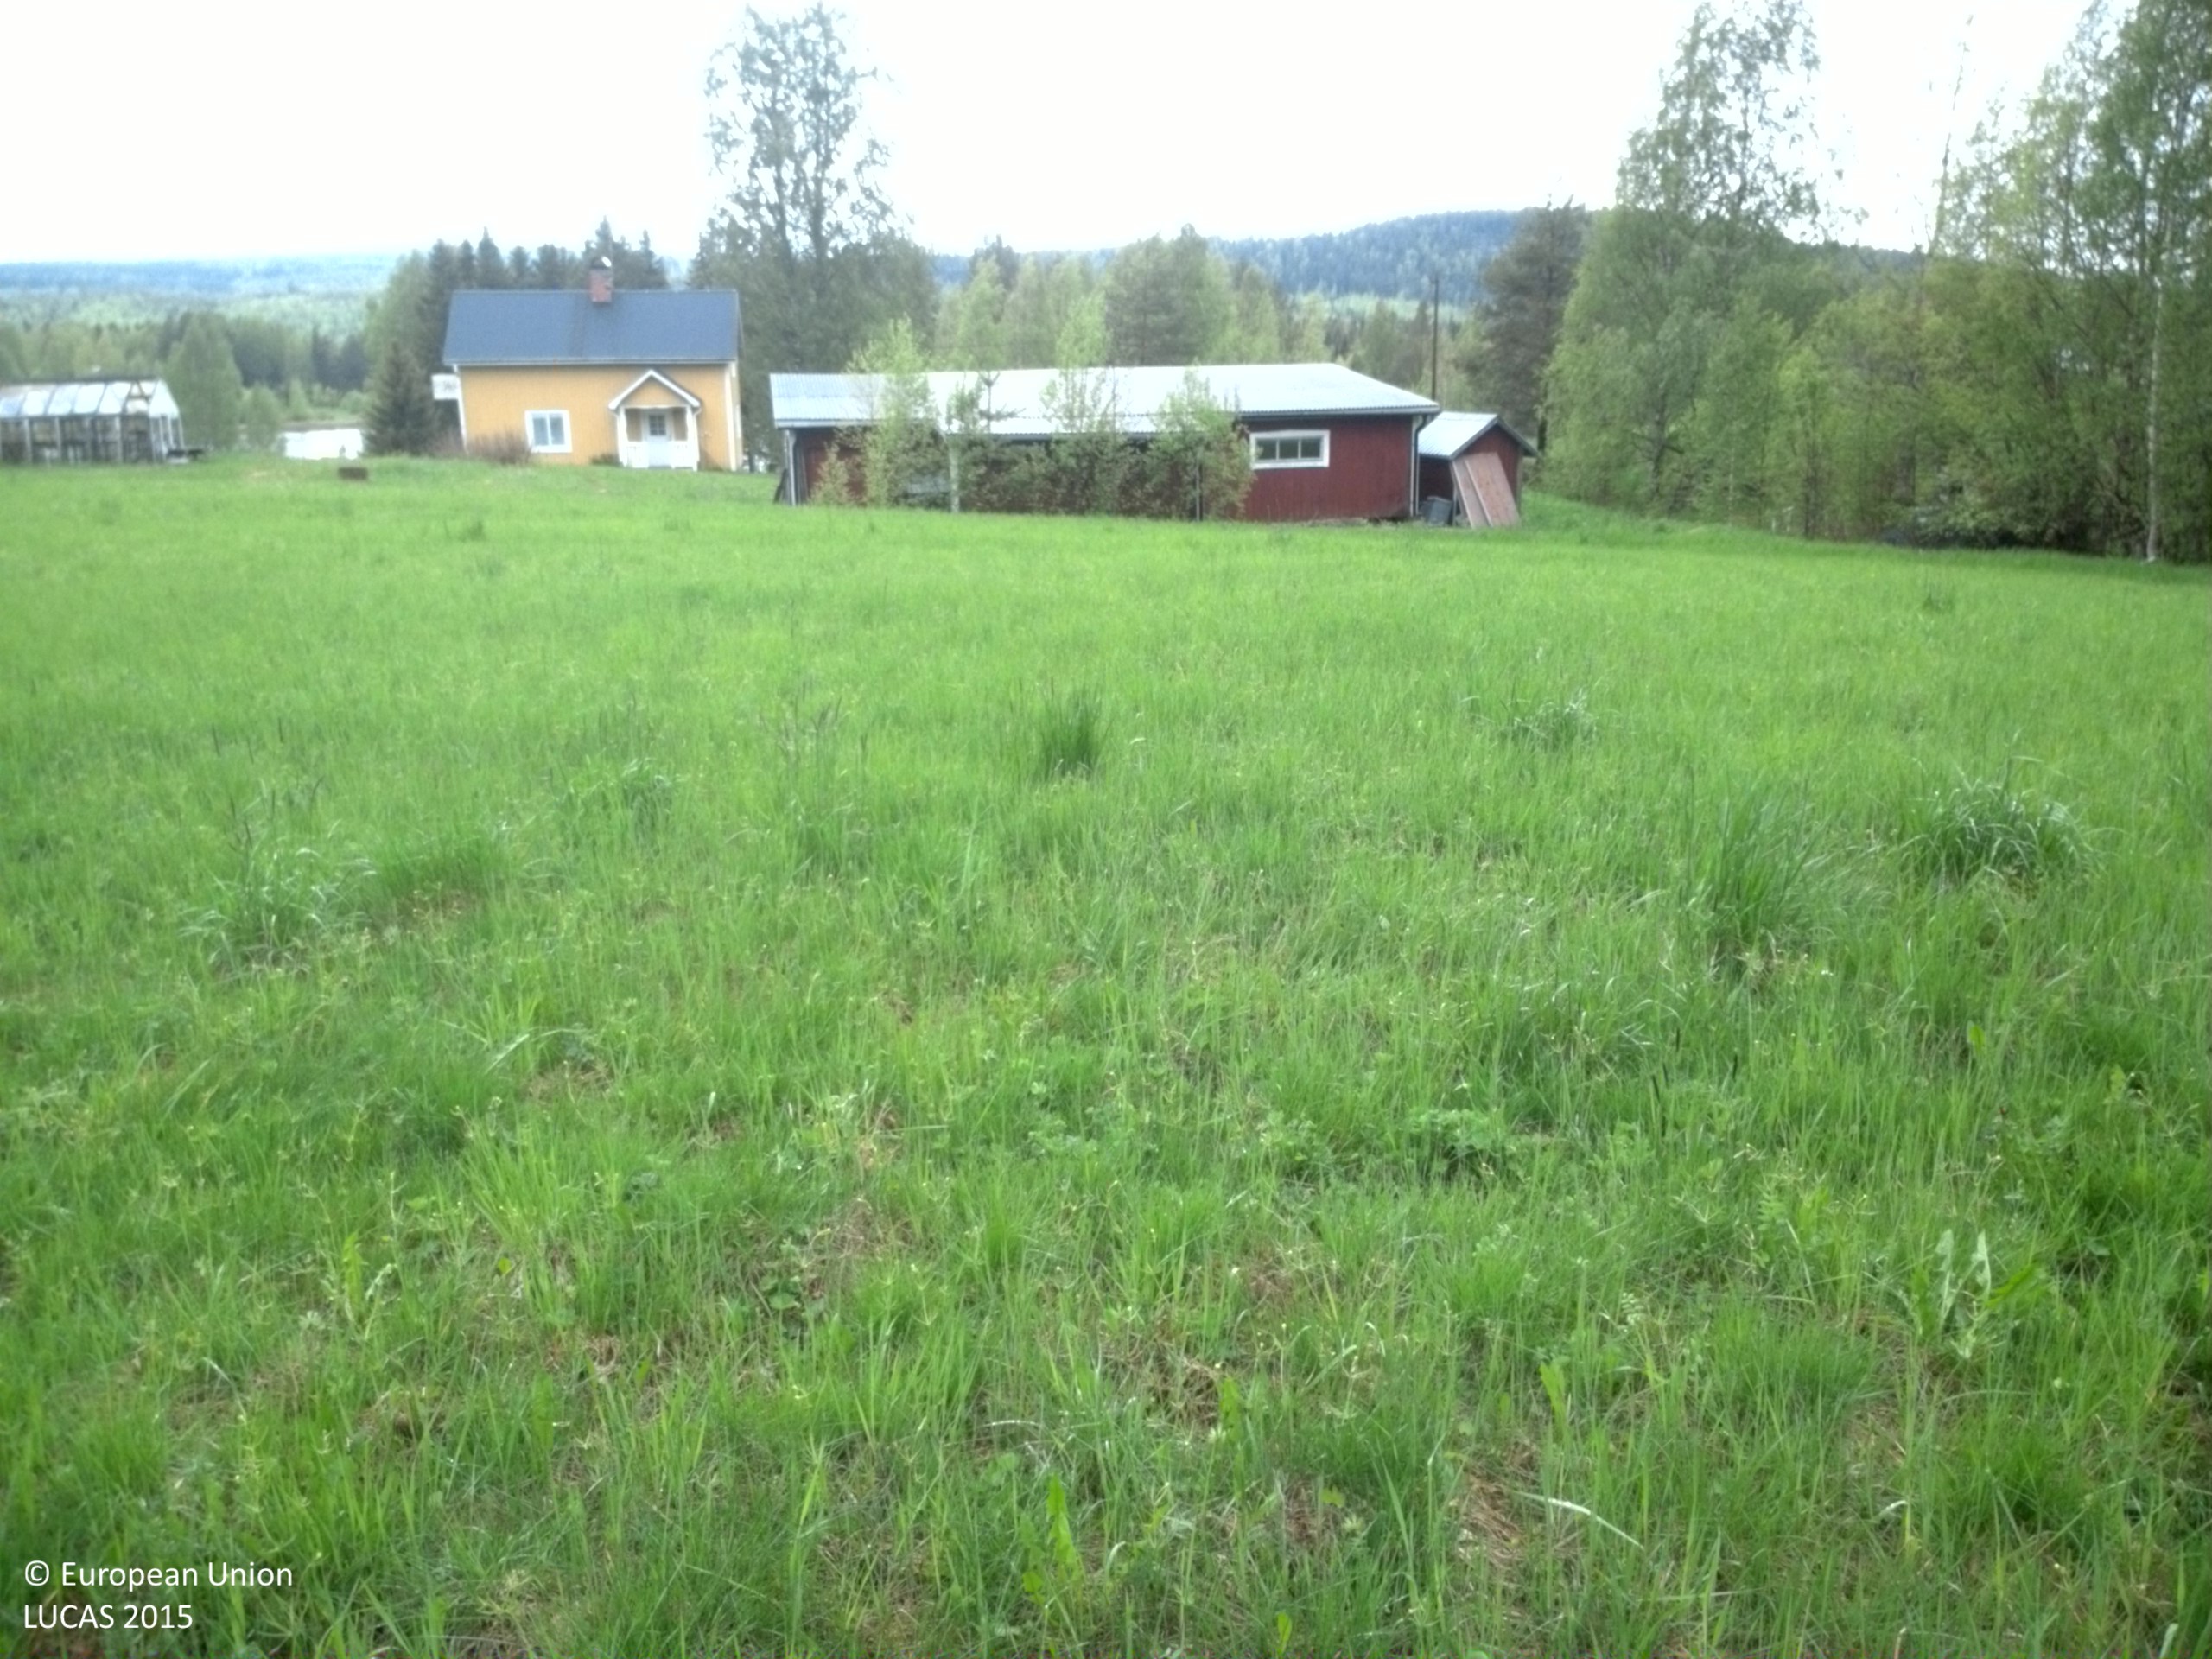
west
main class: Cropland
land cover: Temporary grasslands
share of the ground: > 75 %
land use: Agriculture (excluding fallow land and kitchen gardens)
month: June
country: SE
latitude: 63.2106
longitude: 16.9955
